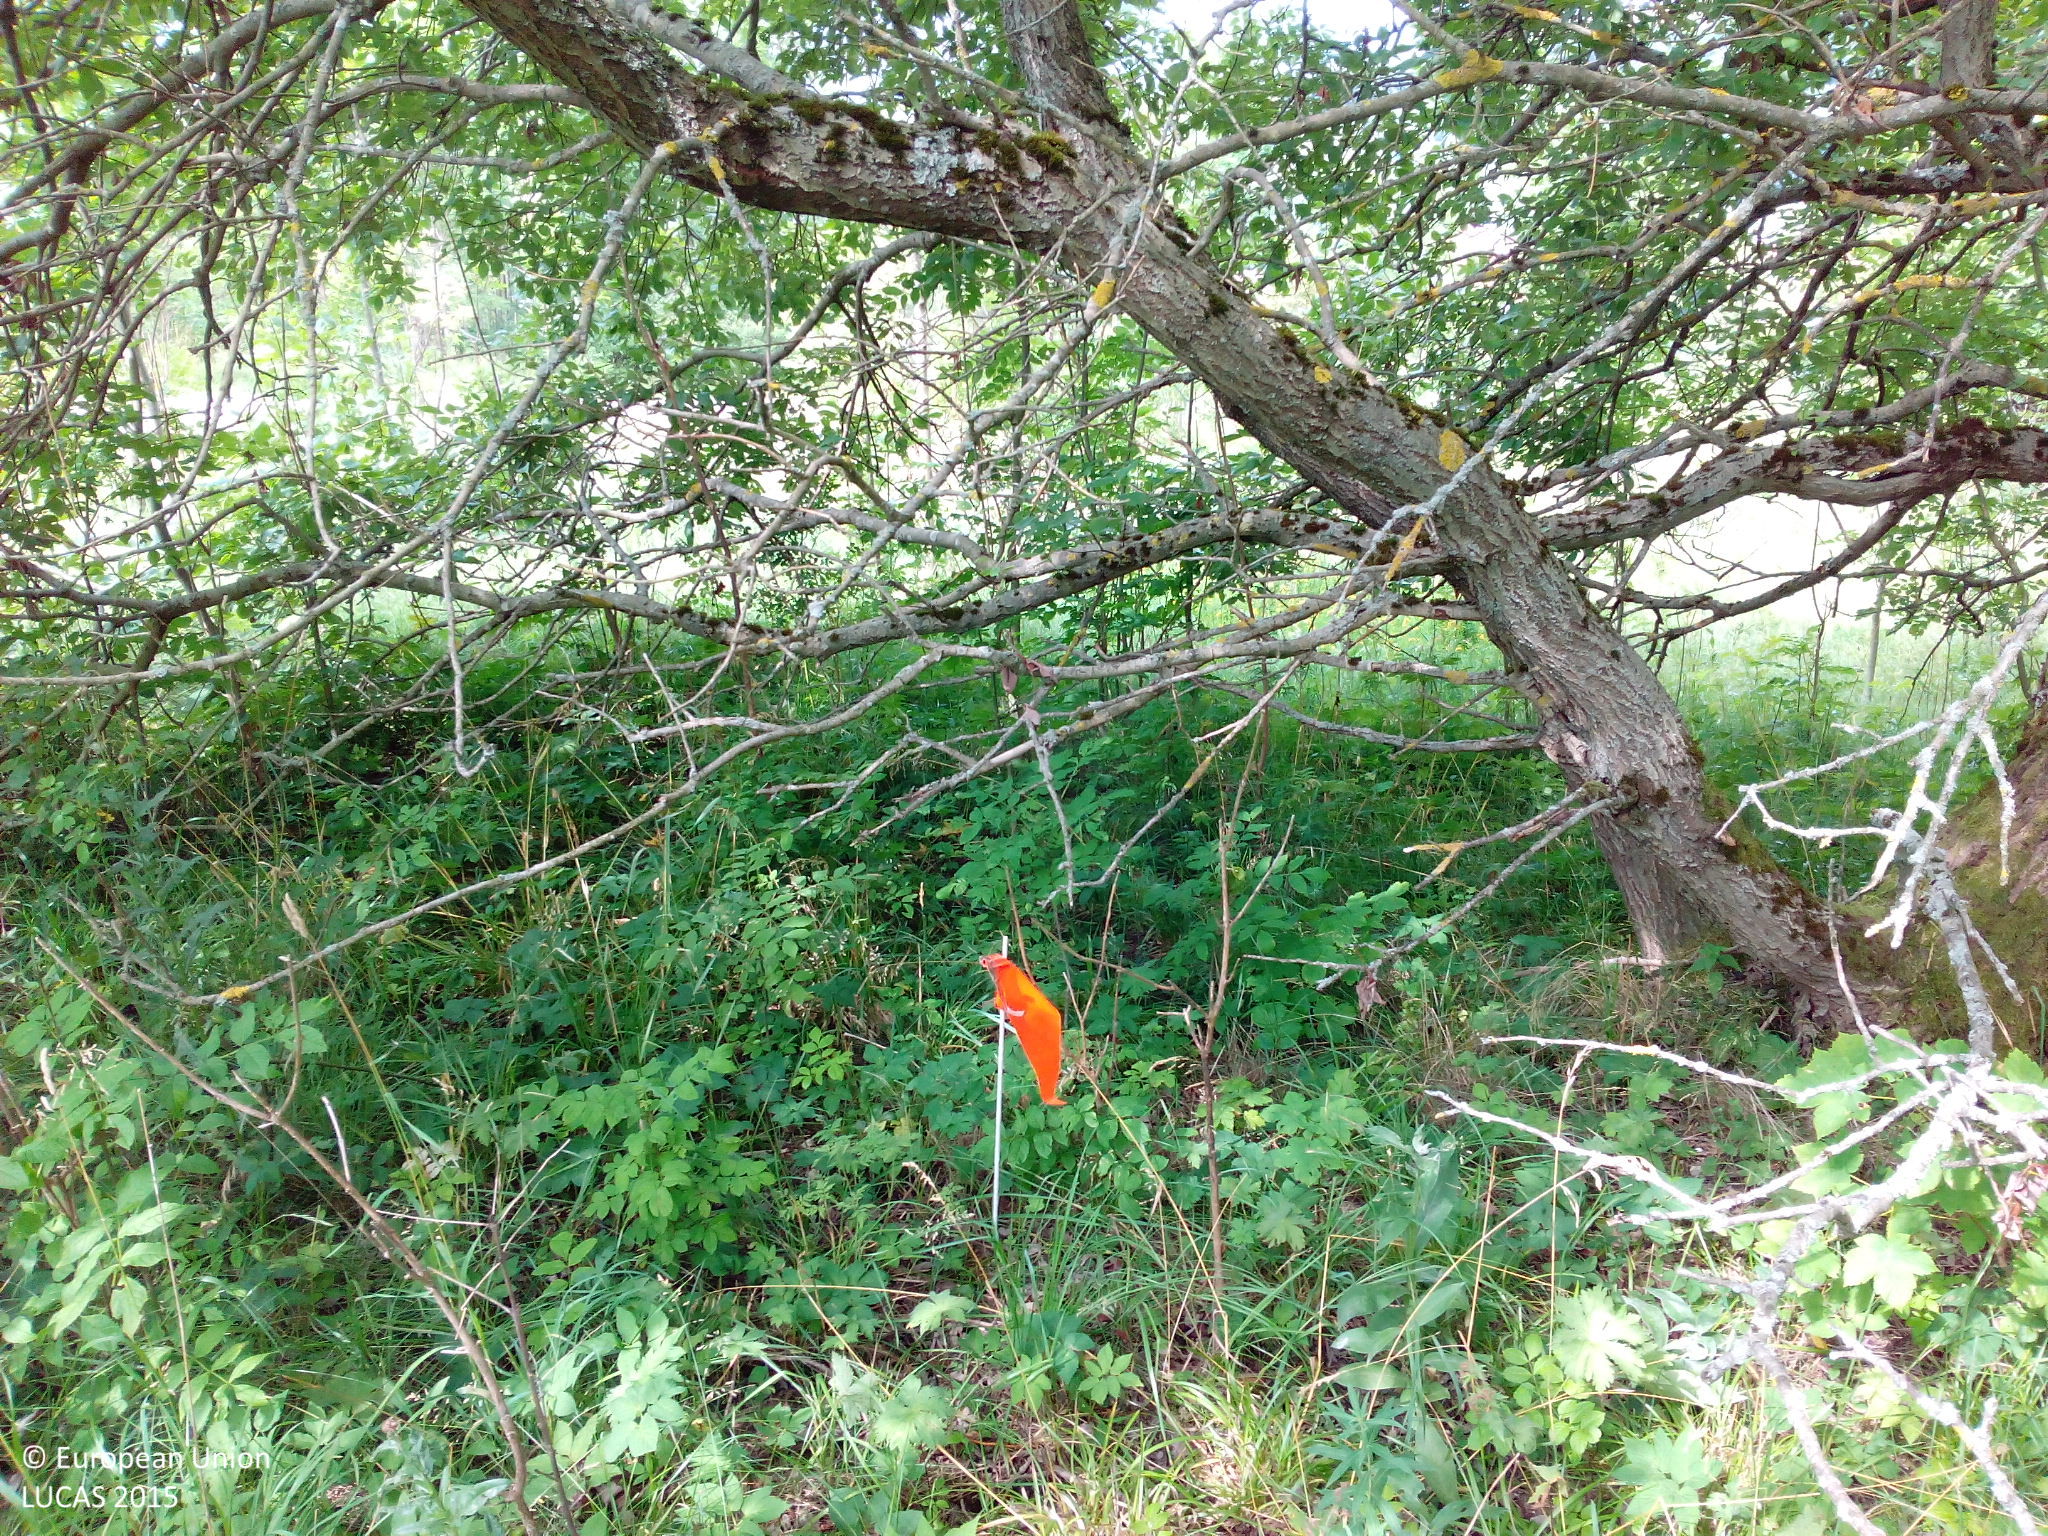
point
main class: Woodland
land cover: Broadleaved woodland
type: mesophytic deciduous forest
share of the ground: > 75 %
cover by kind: broadleaved forest trees 90 %, herbaceous plants 10 %
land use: Forestry
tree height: > 5 m
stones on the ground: < 10 %
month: July
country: DE
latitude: 50.5079
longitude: 9.9295
